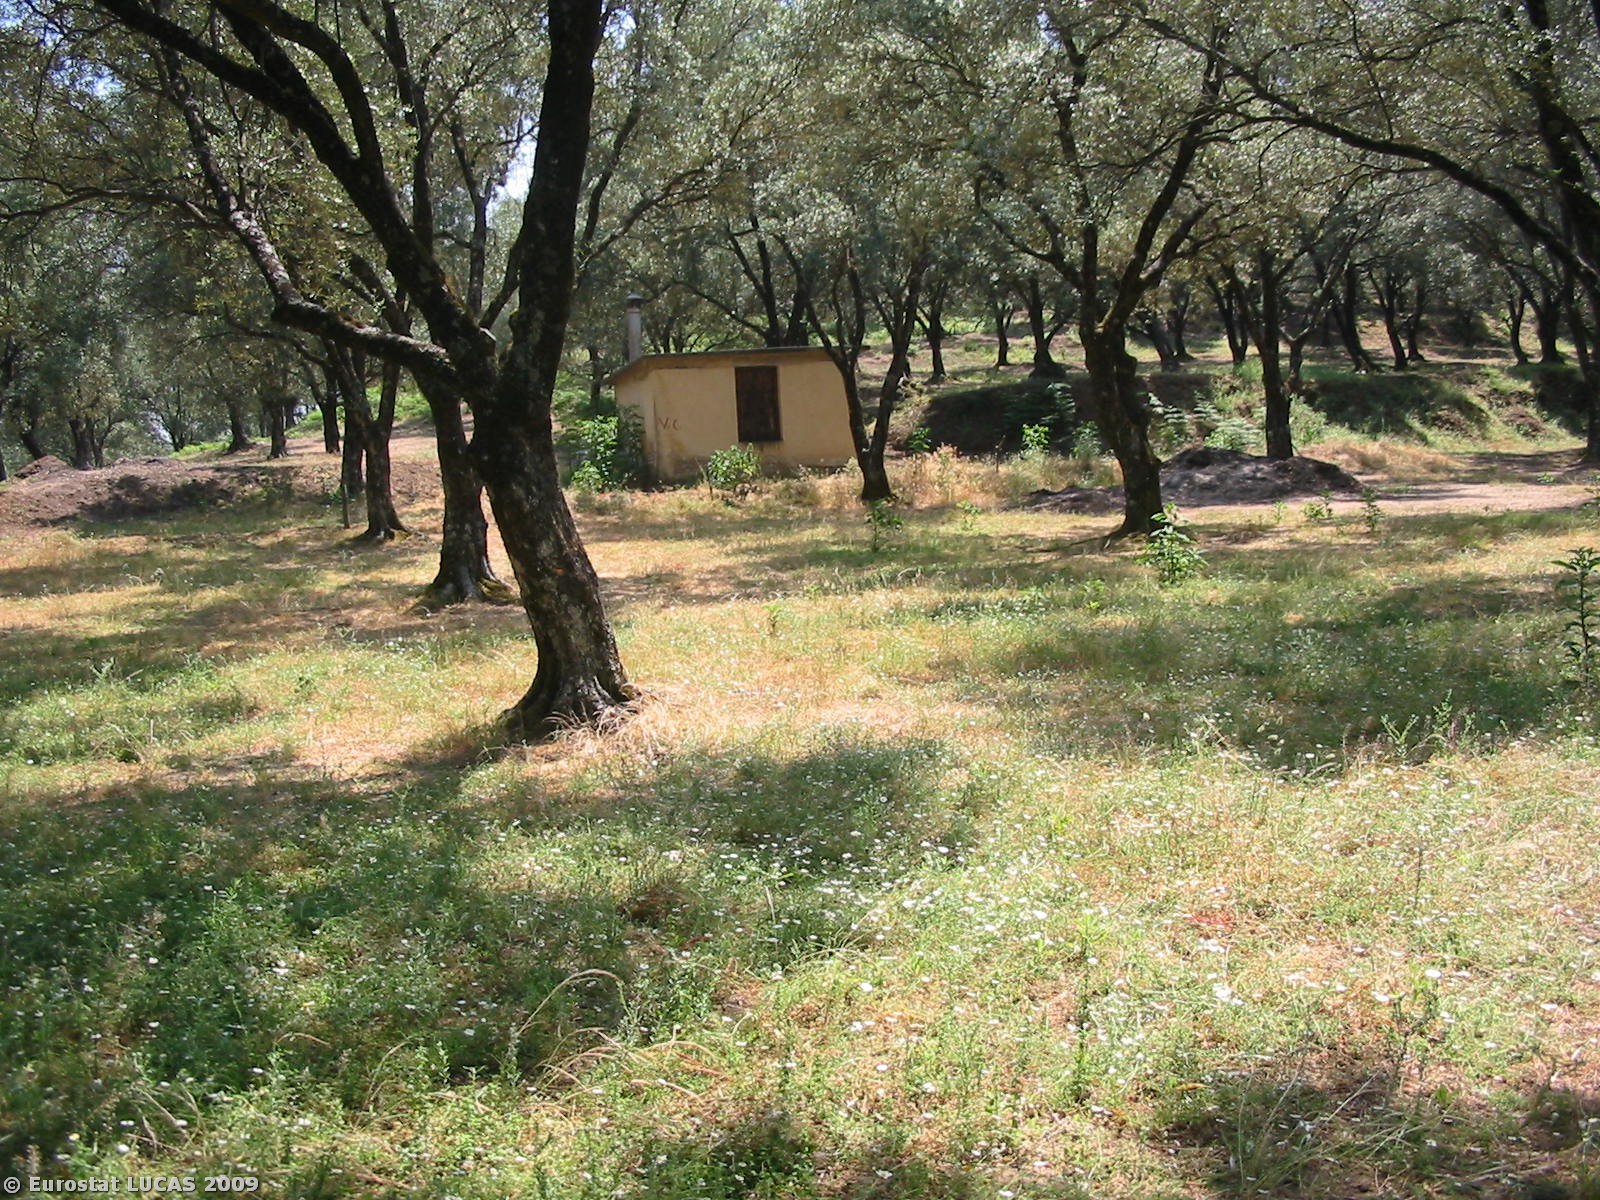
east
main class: Cropland
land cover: Olive groves
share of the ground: 50 - 75 %
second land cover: Spontaneously vegetated surfaces
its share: > 75 %
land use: Agriculture (excluding fallow land and kitchen gardens)
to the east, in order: Olive groves; Spontaneously vegetated surfaces; Fences; Olive groves; Spontaneously vegetated surfaces
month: June
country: IT
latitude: 38.2542
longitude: 15.9178
